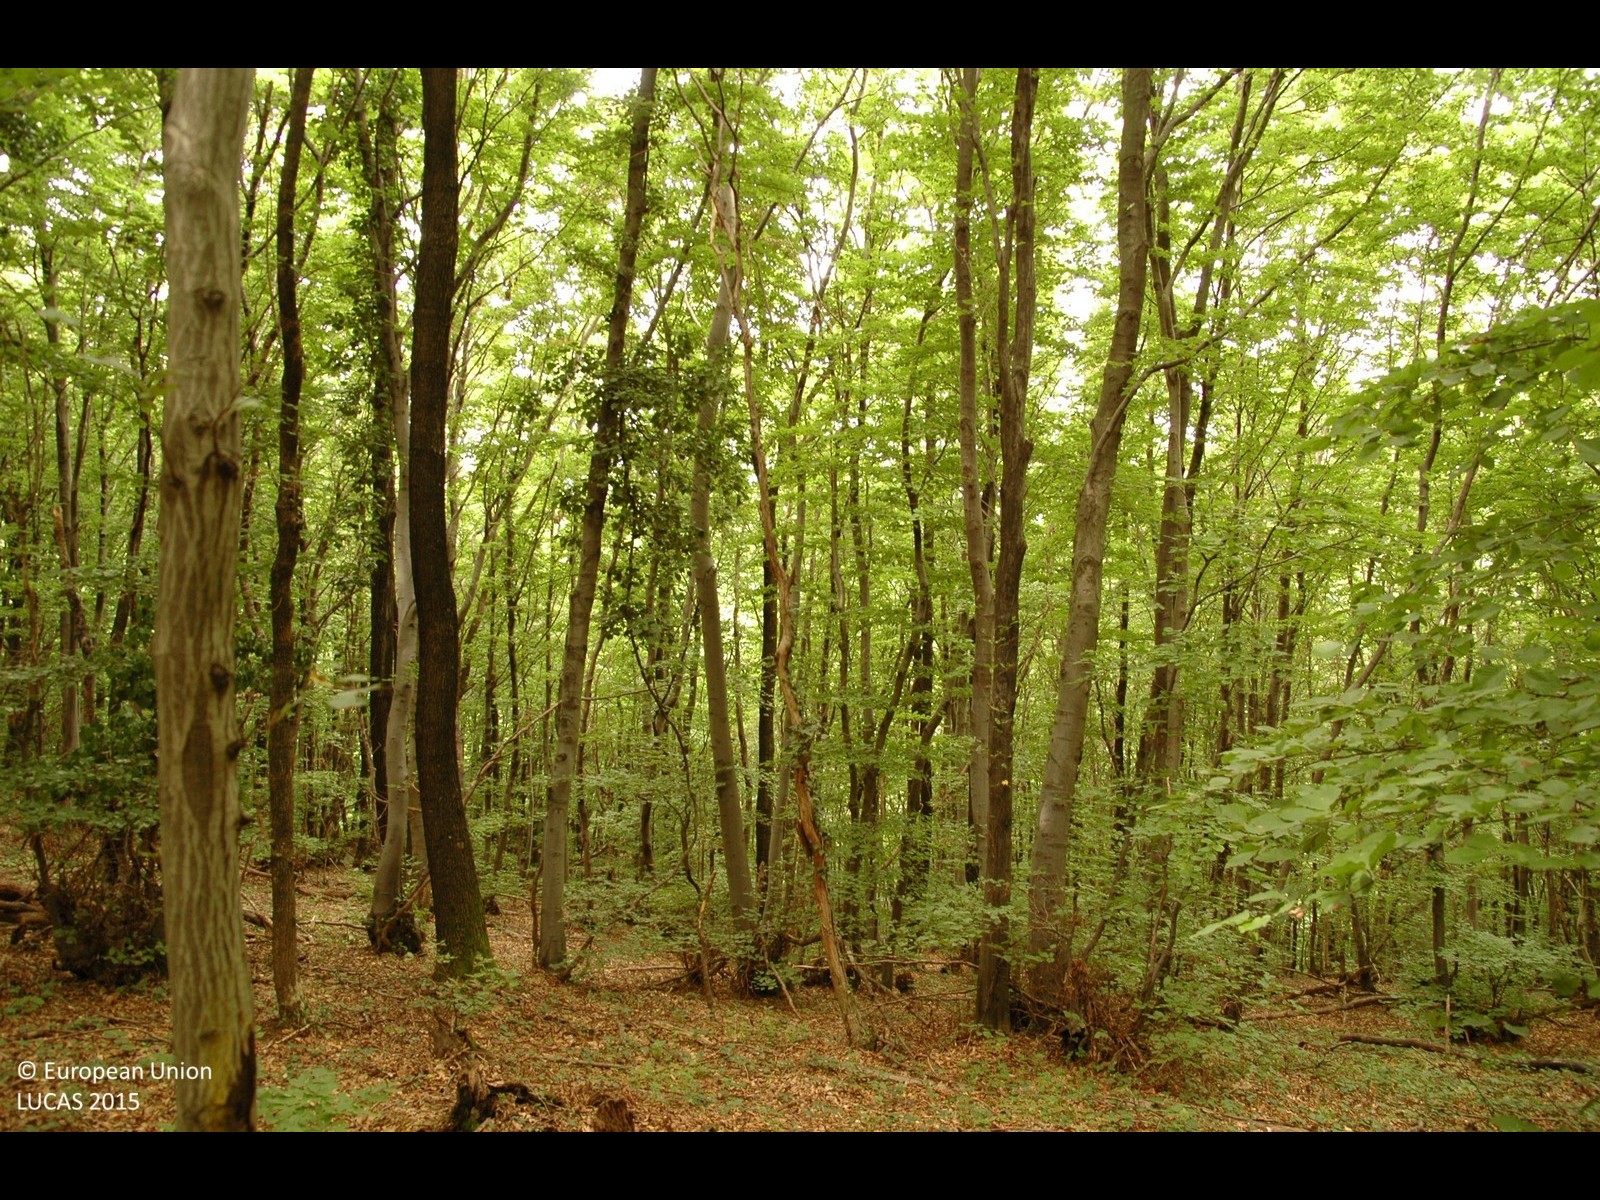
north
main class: Woodland
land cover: Broadleaved woodland
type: mesophytic deciduous forest
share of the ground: > 75 %
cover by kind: broadleaved forest trees 100 %
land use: Forestry
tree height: > 5 m
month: August
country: HR
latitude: 45.8884
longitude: 16.0937
